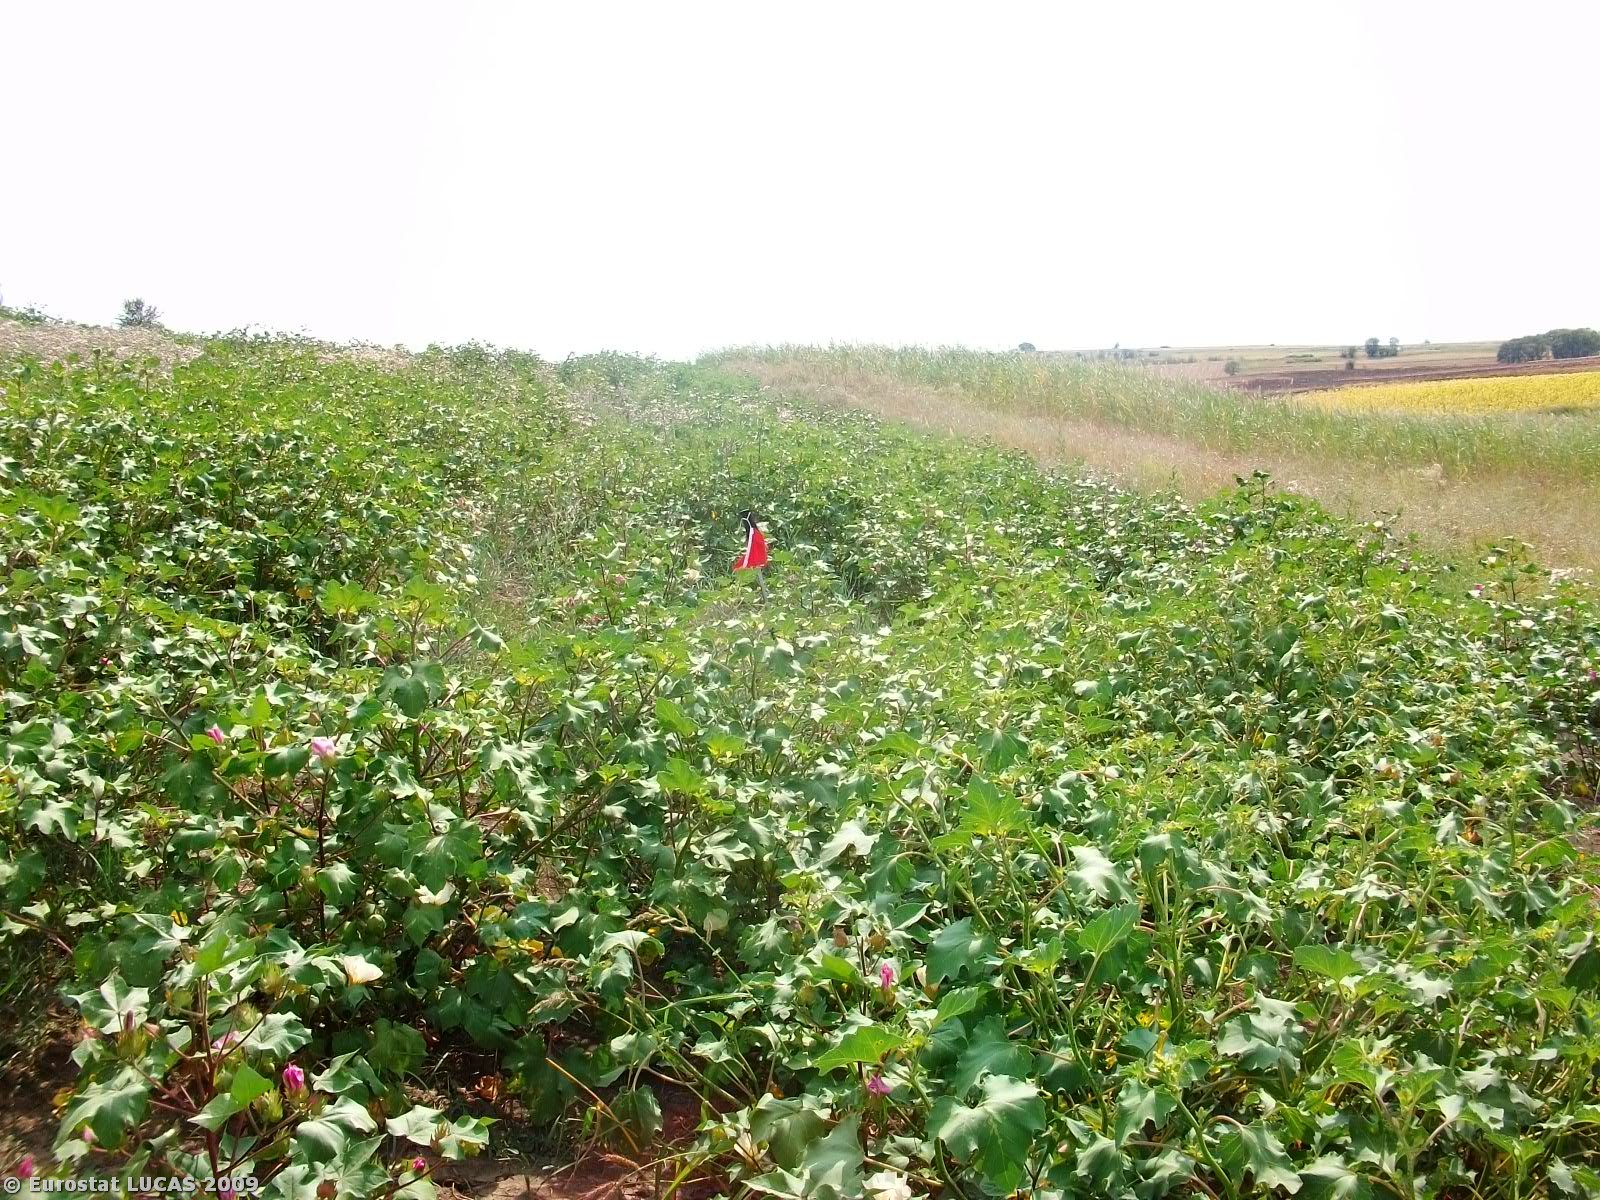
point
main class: Cropland
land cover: Cotton
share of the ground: 50 - 75 %
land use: Agriculture (excluding fallow land and kitchen gardens)
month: August
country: GR
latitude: 41.4980
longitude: 26.3550
